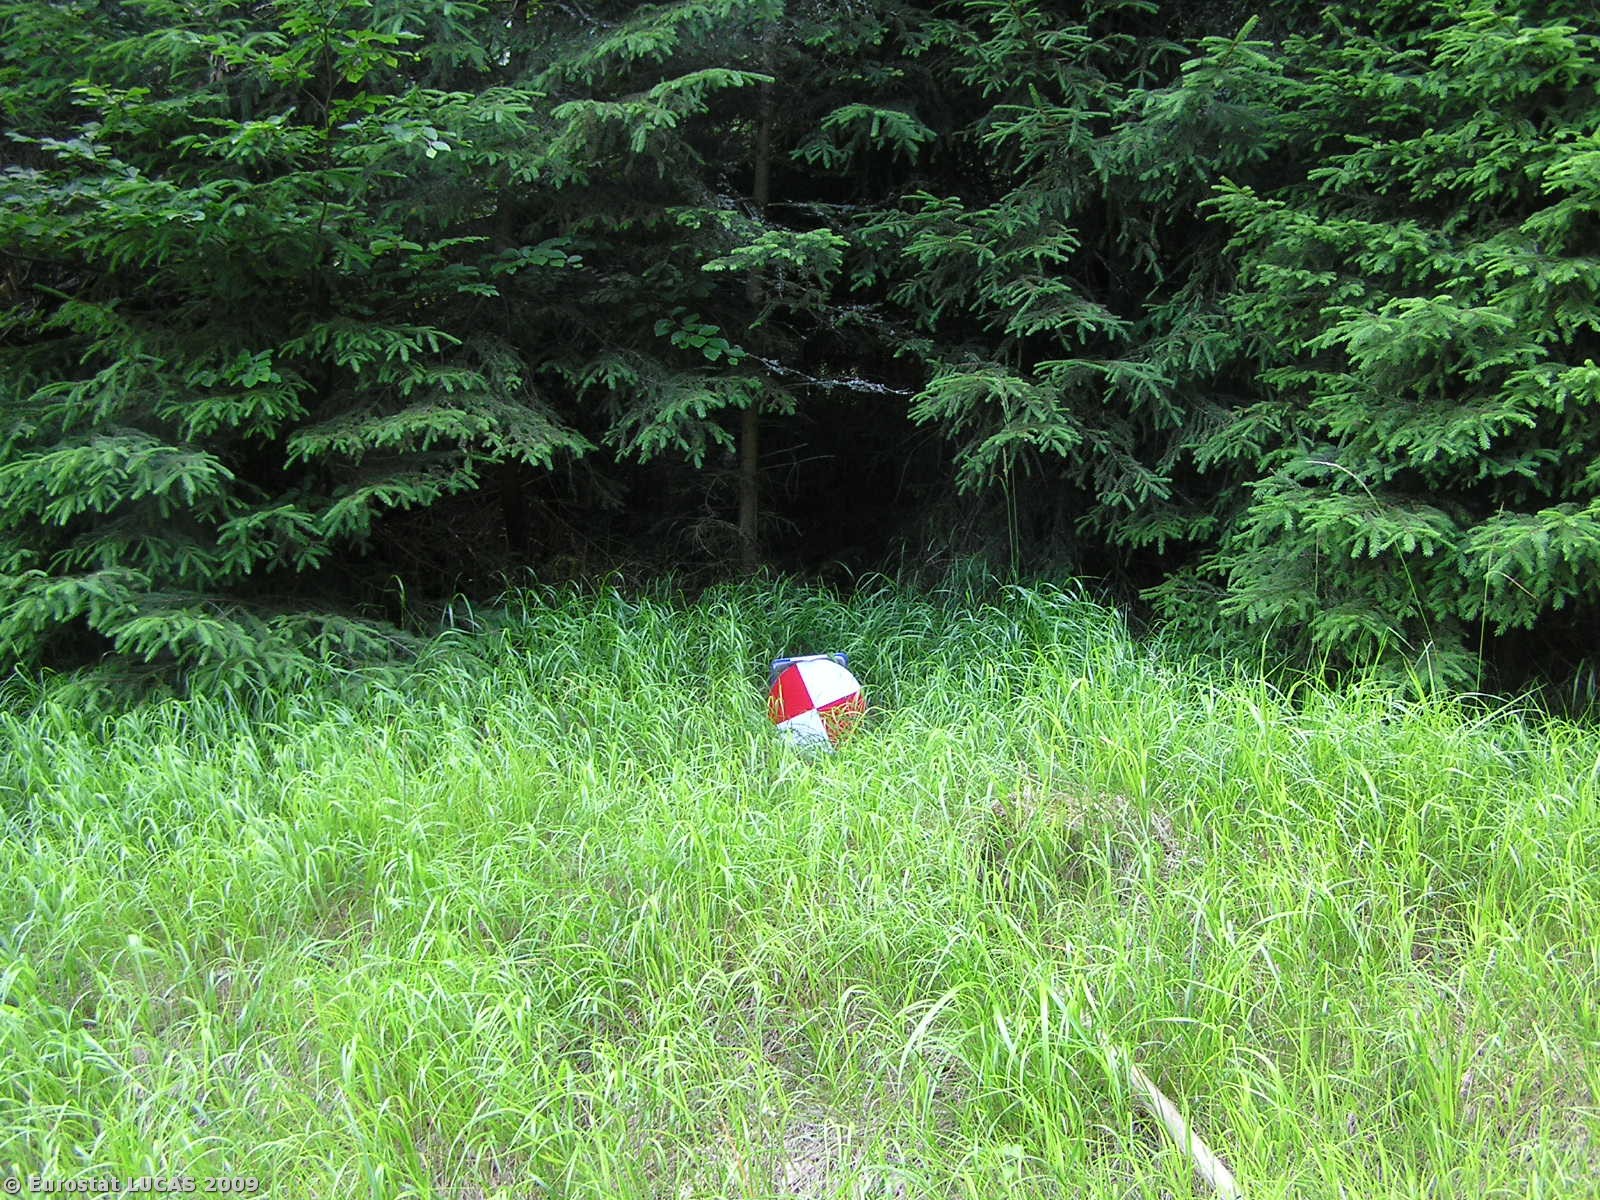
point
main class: Woodland
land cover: Coniferous woodland
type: hemiboreal forest and nemoral coniferous forest and mixed broadleaved-coniferous forest
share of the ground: > 75 %
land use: Forestry
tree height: > 5 m
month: July
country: CZ
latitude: 50.1001
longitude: 17.4919
